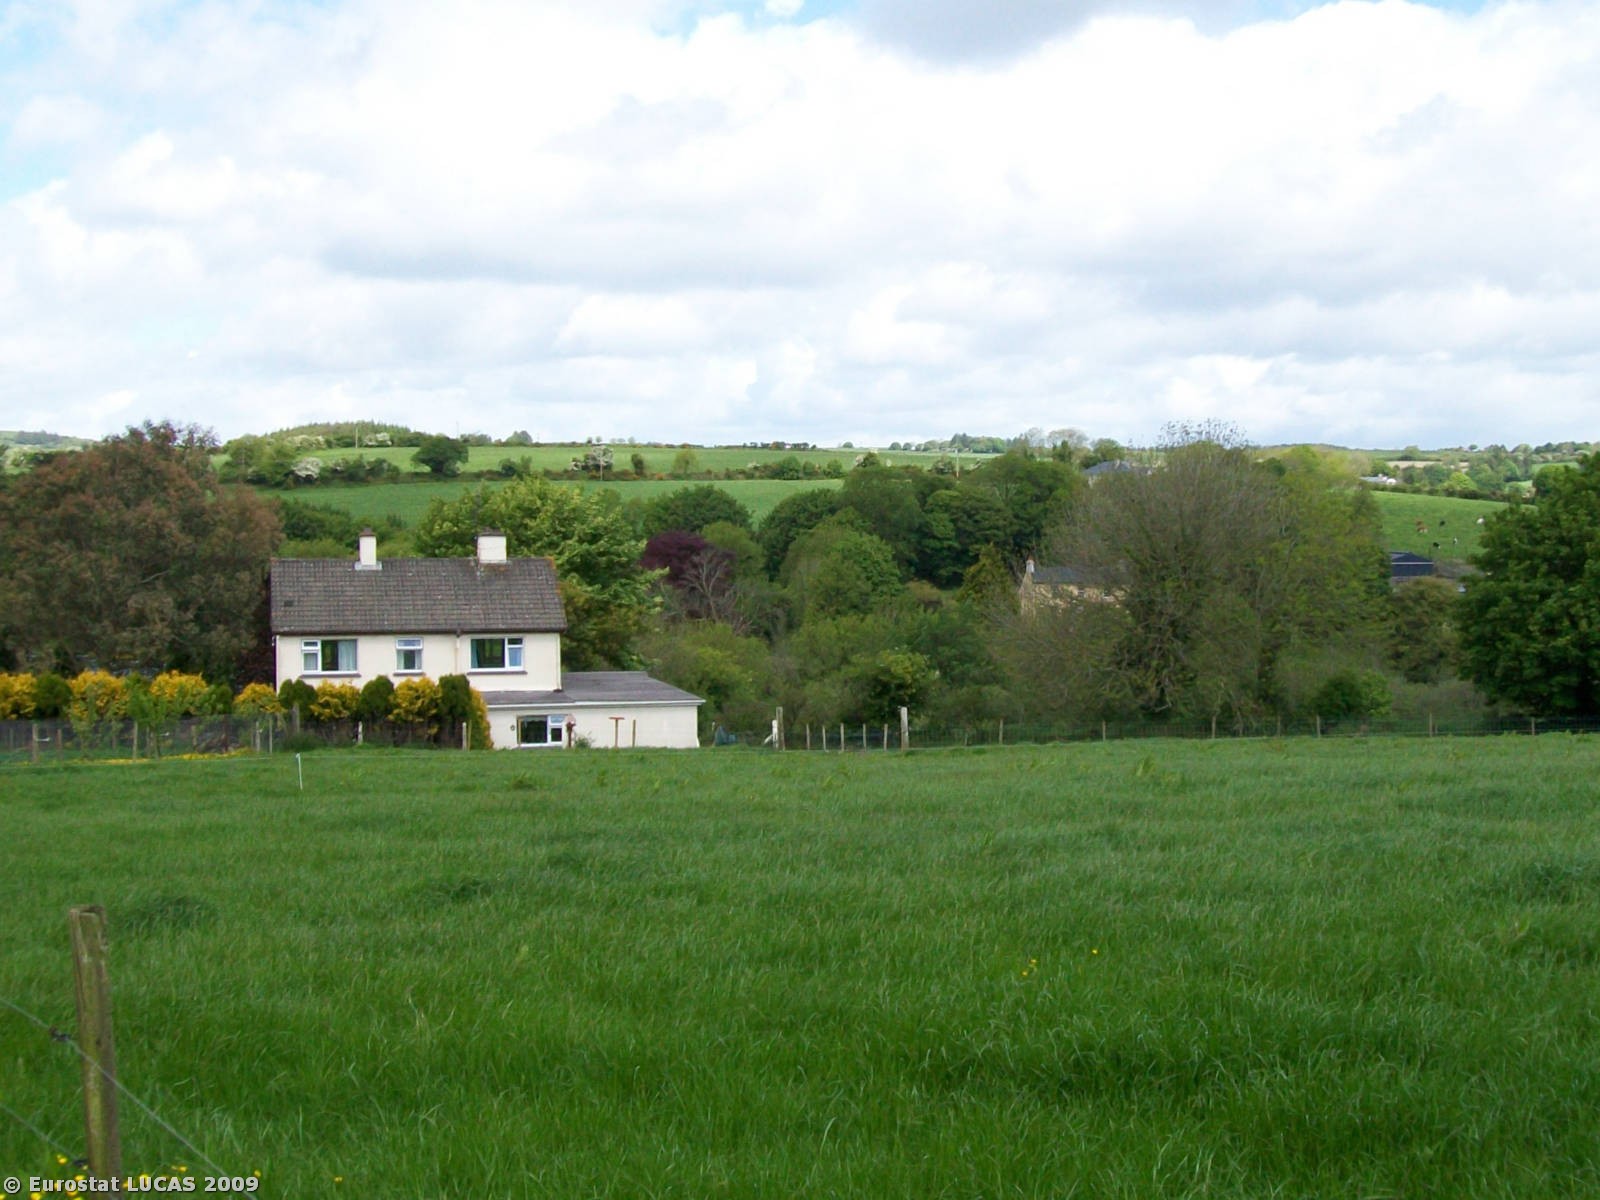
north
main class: Grassland
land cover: Grassland without tree/shrub cover
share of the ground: > 75 %
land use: Agriculture (excluding fallow land and kitchen gardens)
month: May
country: IE
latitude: 51.7837
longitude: -8.7735
